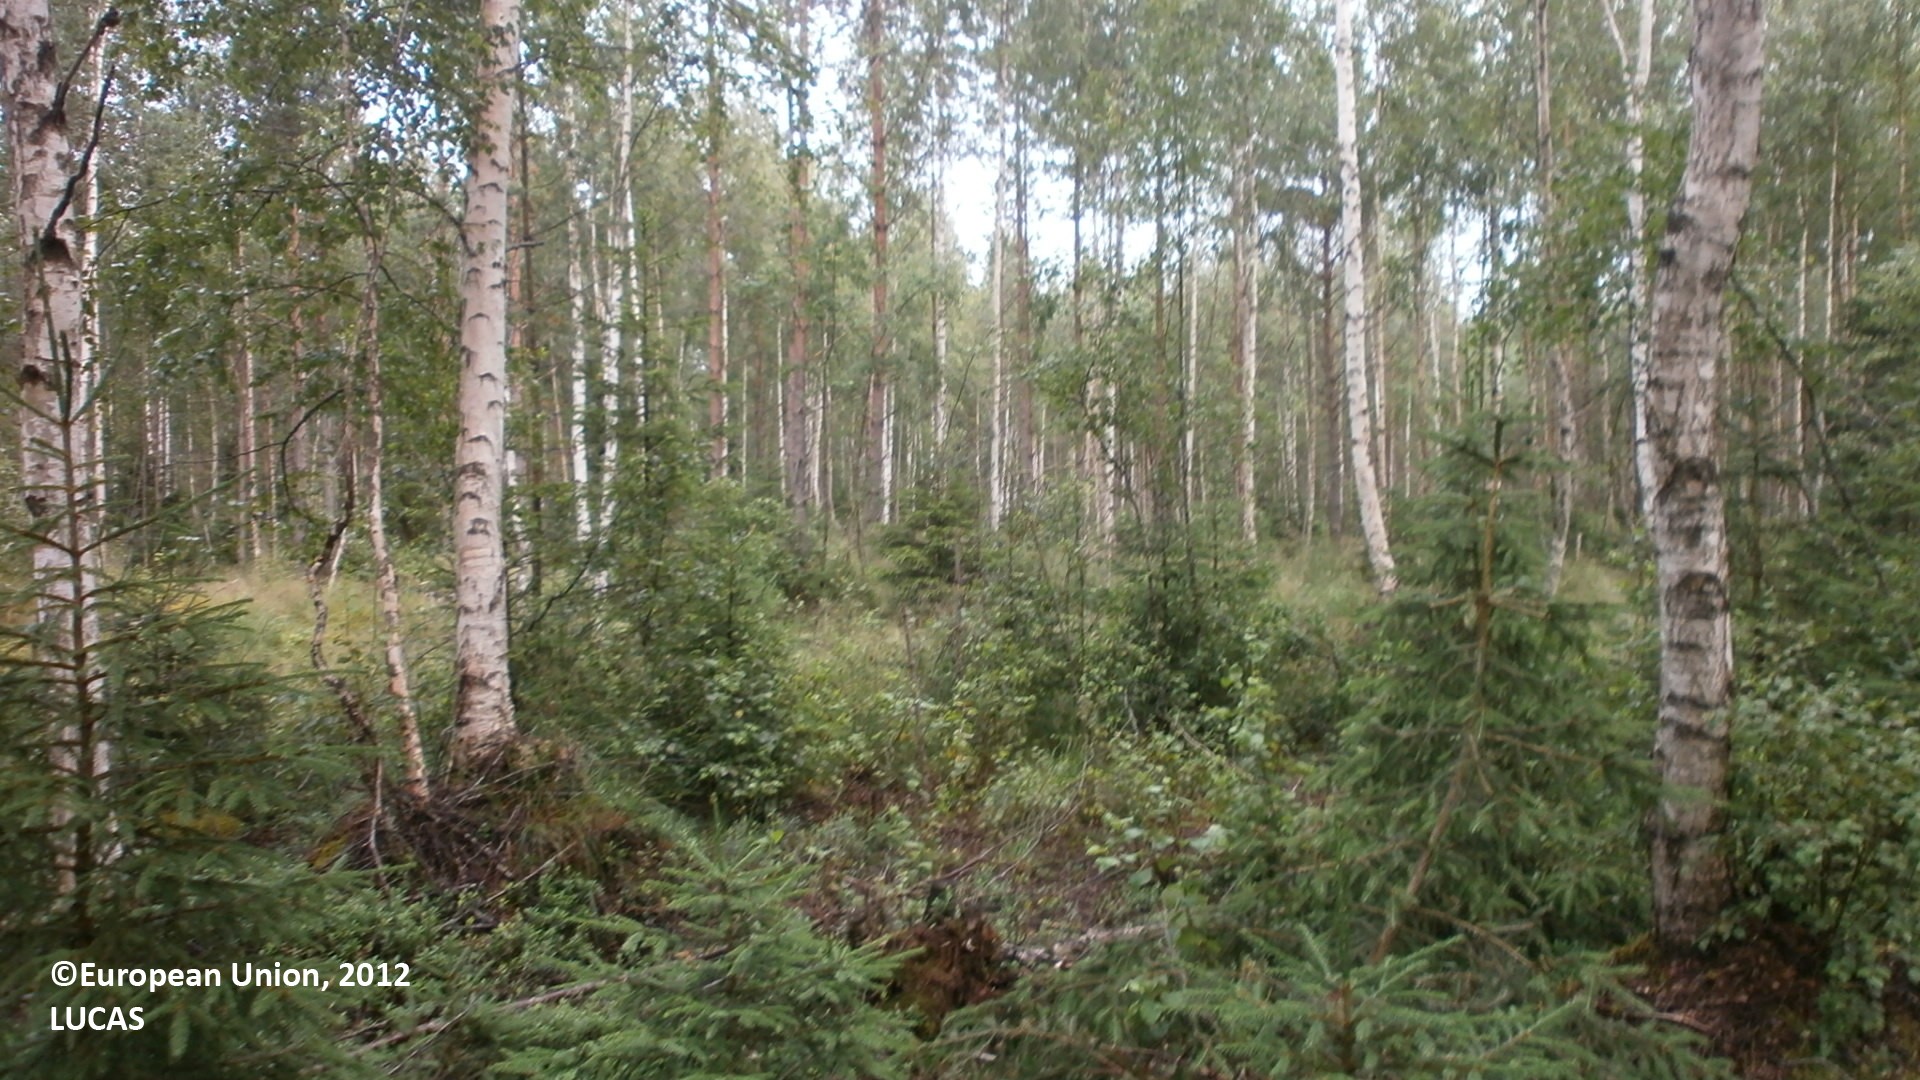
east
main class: Woodland
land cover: Pine dominated mixed woodland
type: boreal forest
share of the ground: 50 - 75 %
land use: Forestry
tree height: > 5 m
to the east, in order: Pine dominated mixed woodland; Tracks; Ditches and canals; Pine dominated mixed woodland; Ditches and canals; Pine dominated mixed woodland; Tracks; Pine dominated mixed woodland; Tracks; Pine dominated coniferous woodland; Ditches and canals; Pine dominated mixed woodland
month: July
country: FI
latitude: 64.1086
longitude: 23.7505
